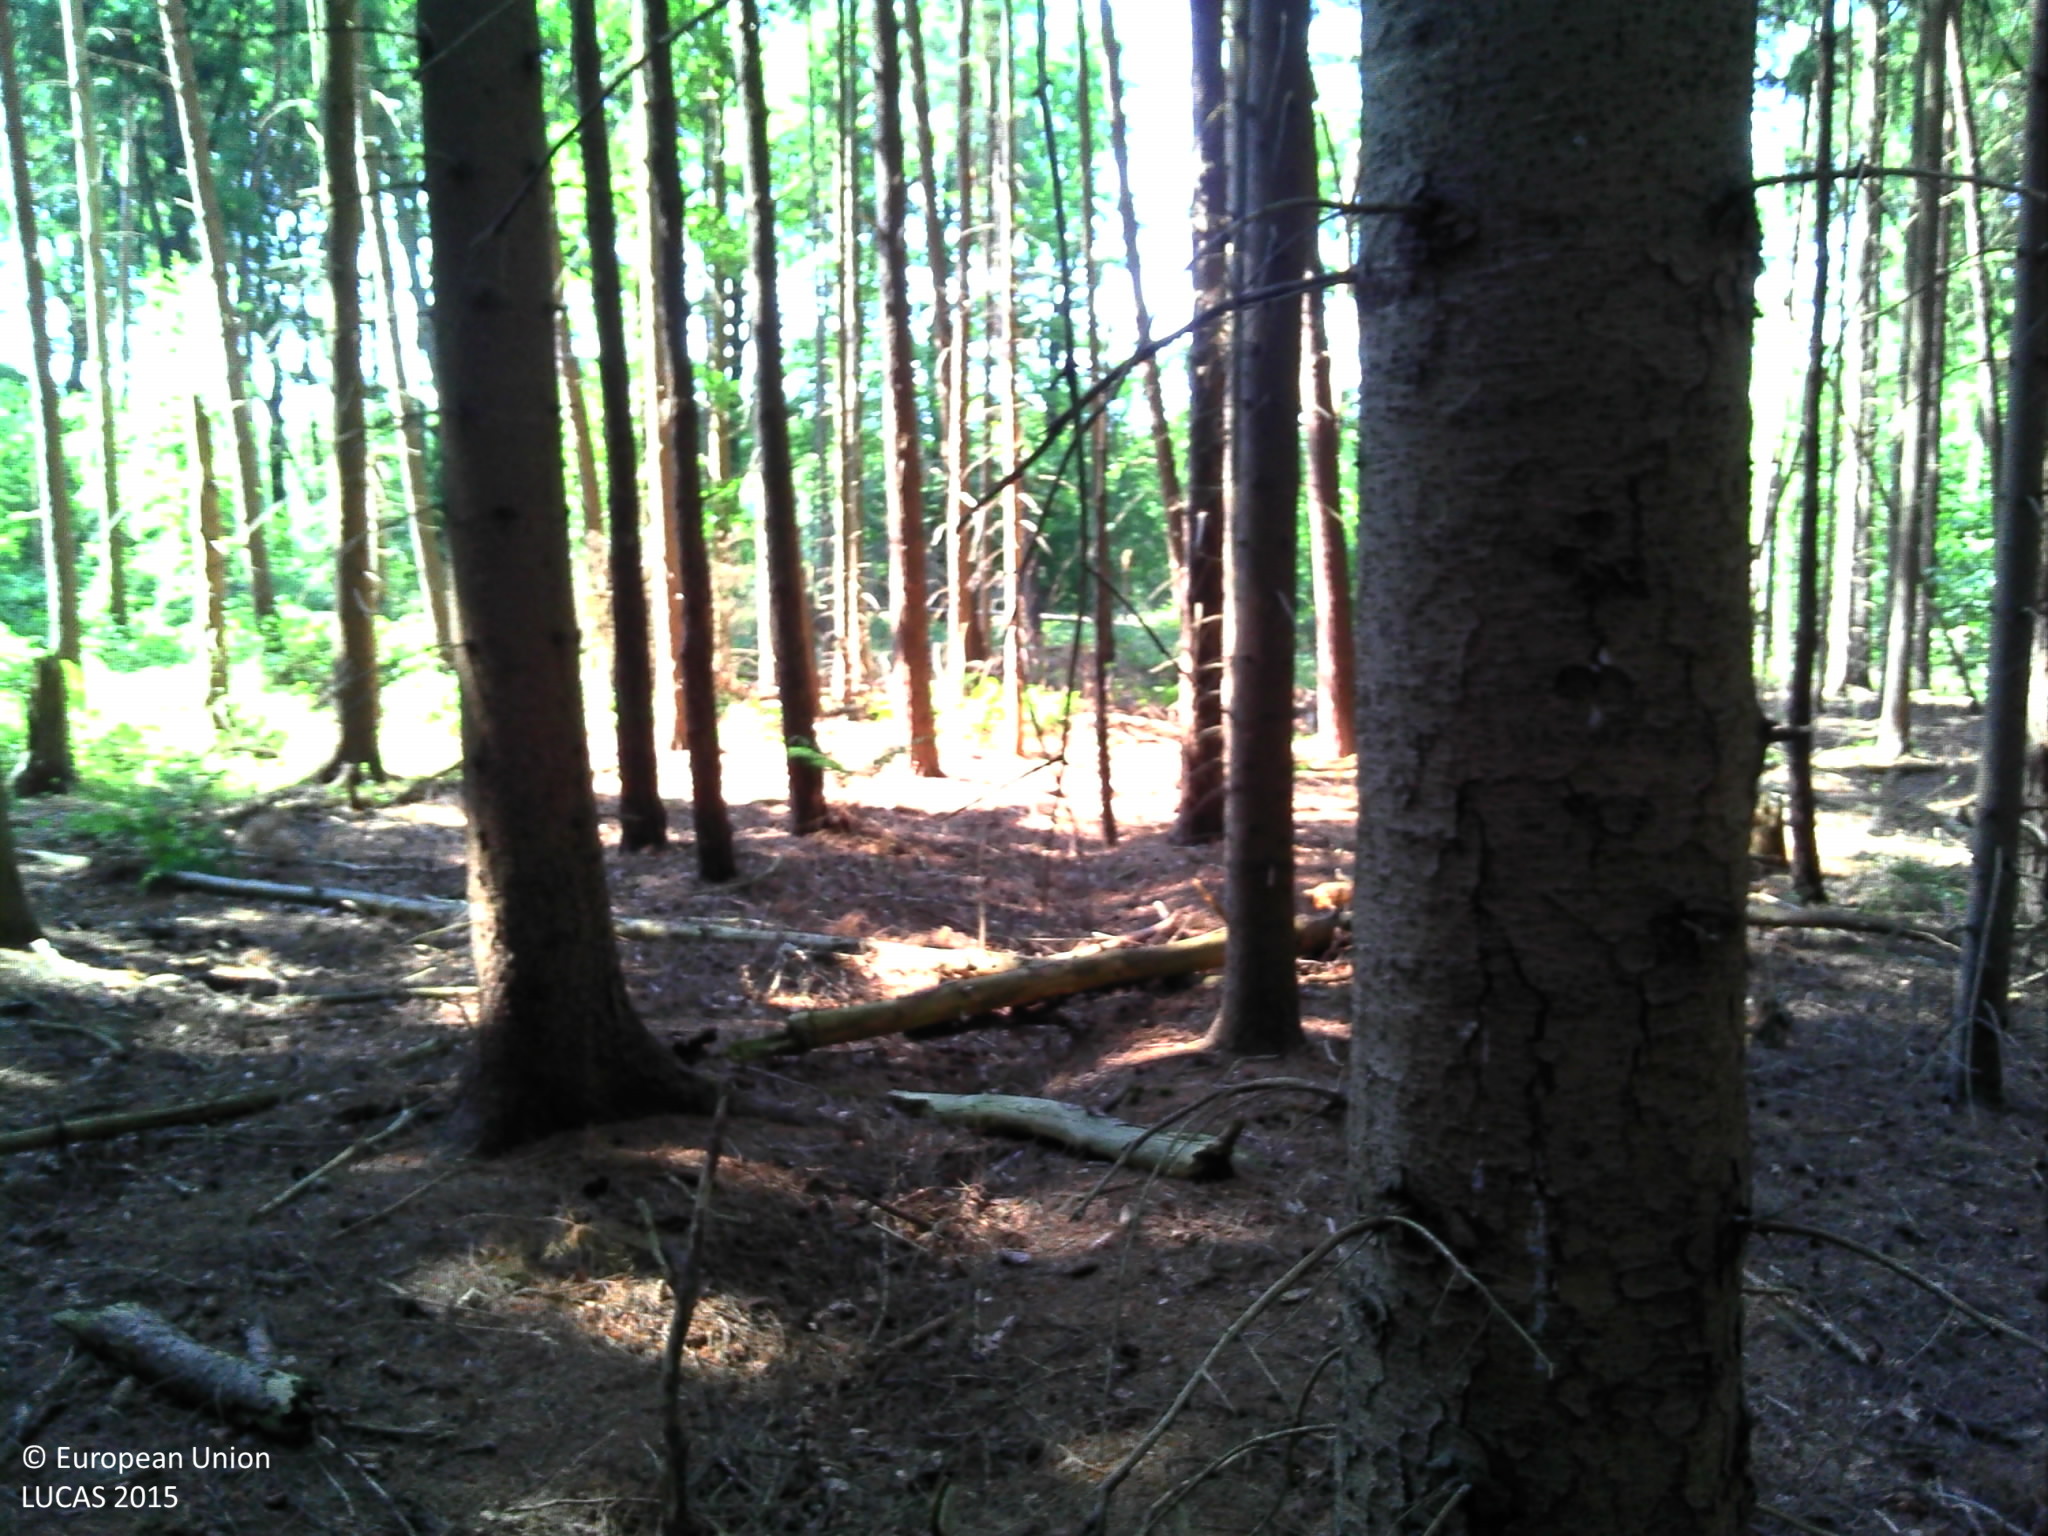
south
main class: Woodland
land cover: Pine dominated coniferous woodland
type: exotic forest
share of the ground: > 75 %
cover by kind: coniferous forest trees 90 %, unconsolidated bare surface 10 %
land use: Forestry
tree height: > 5 m
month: July
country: BE
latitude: 51.1509
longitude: 3.4586
